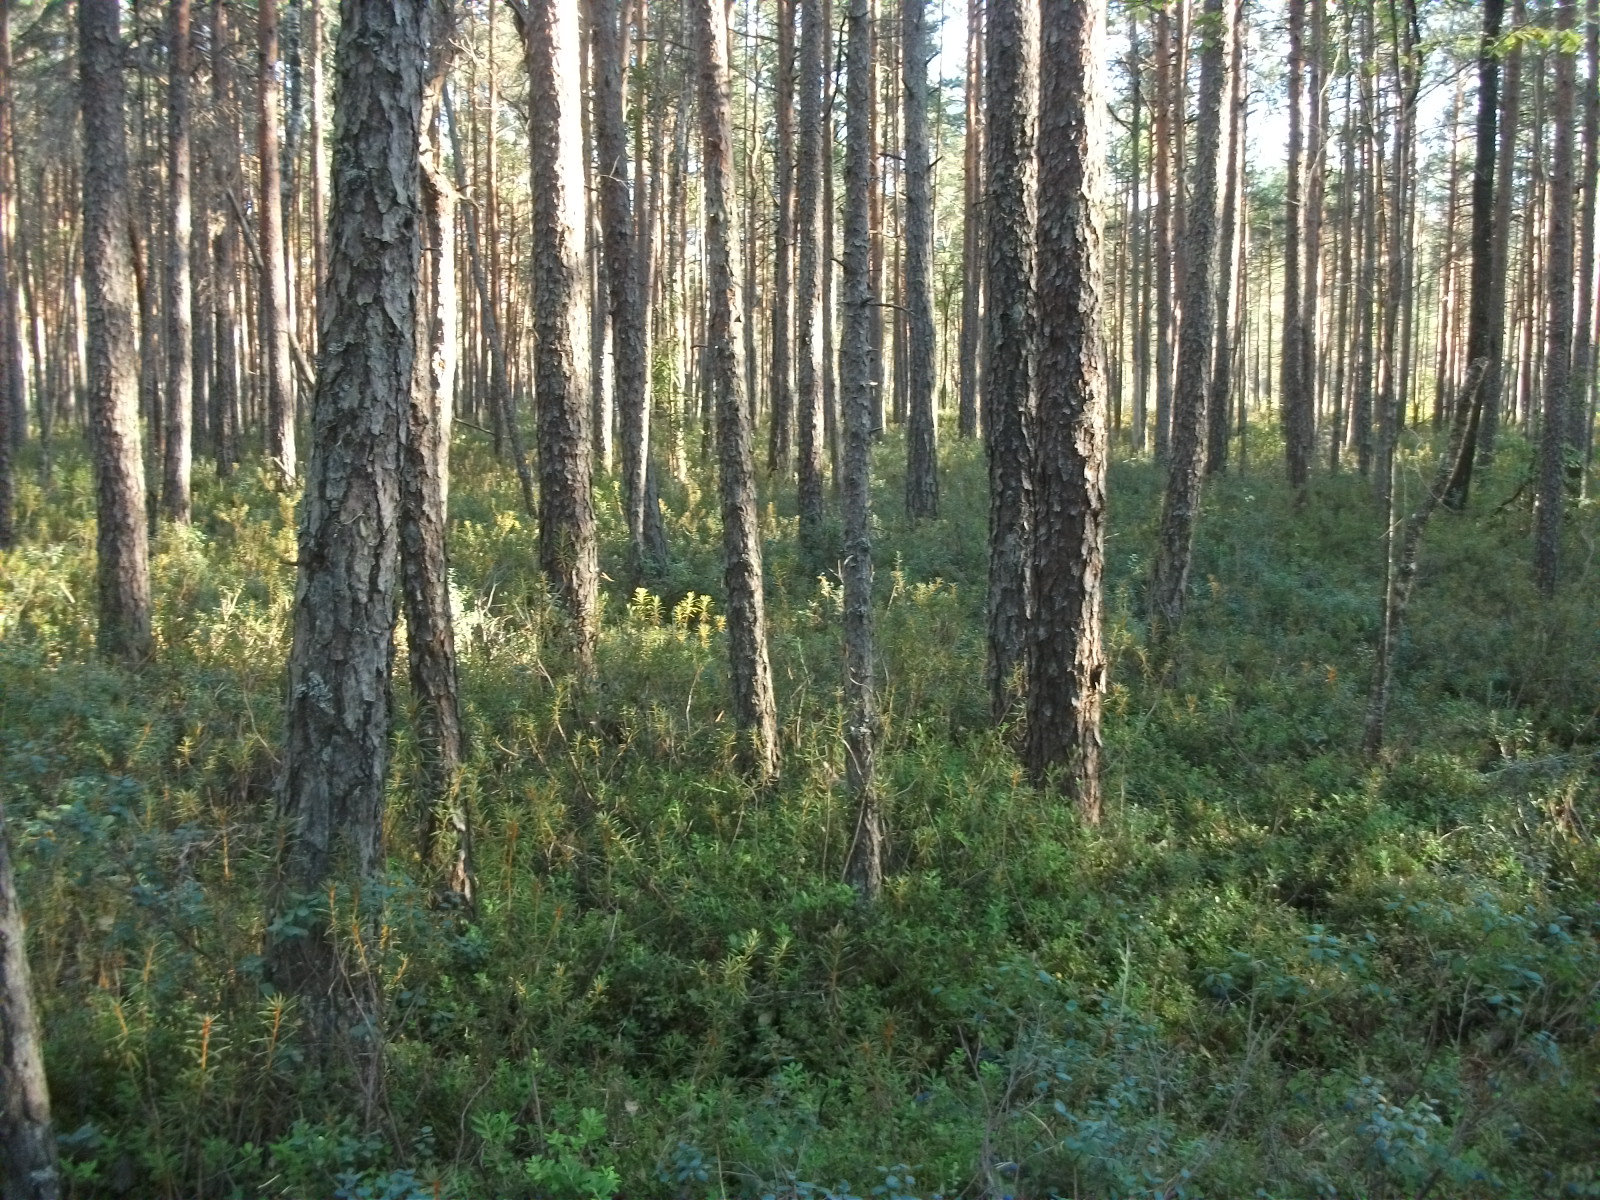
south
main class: Woodland
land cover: Pine dominated coniferous woodland
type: hemiboreal forest and nemoral coniferous forest and mixed broadleaved-coniferous forest
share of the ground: > 75 %
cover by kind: coniferous forest trees 85 %, lichens and mosses 15 %
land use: Forestry
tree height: > 5 m
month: August
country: LV
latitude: 56.5222
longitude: 26.3829
